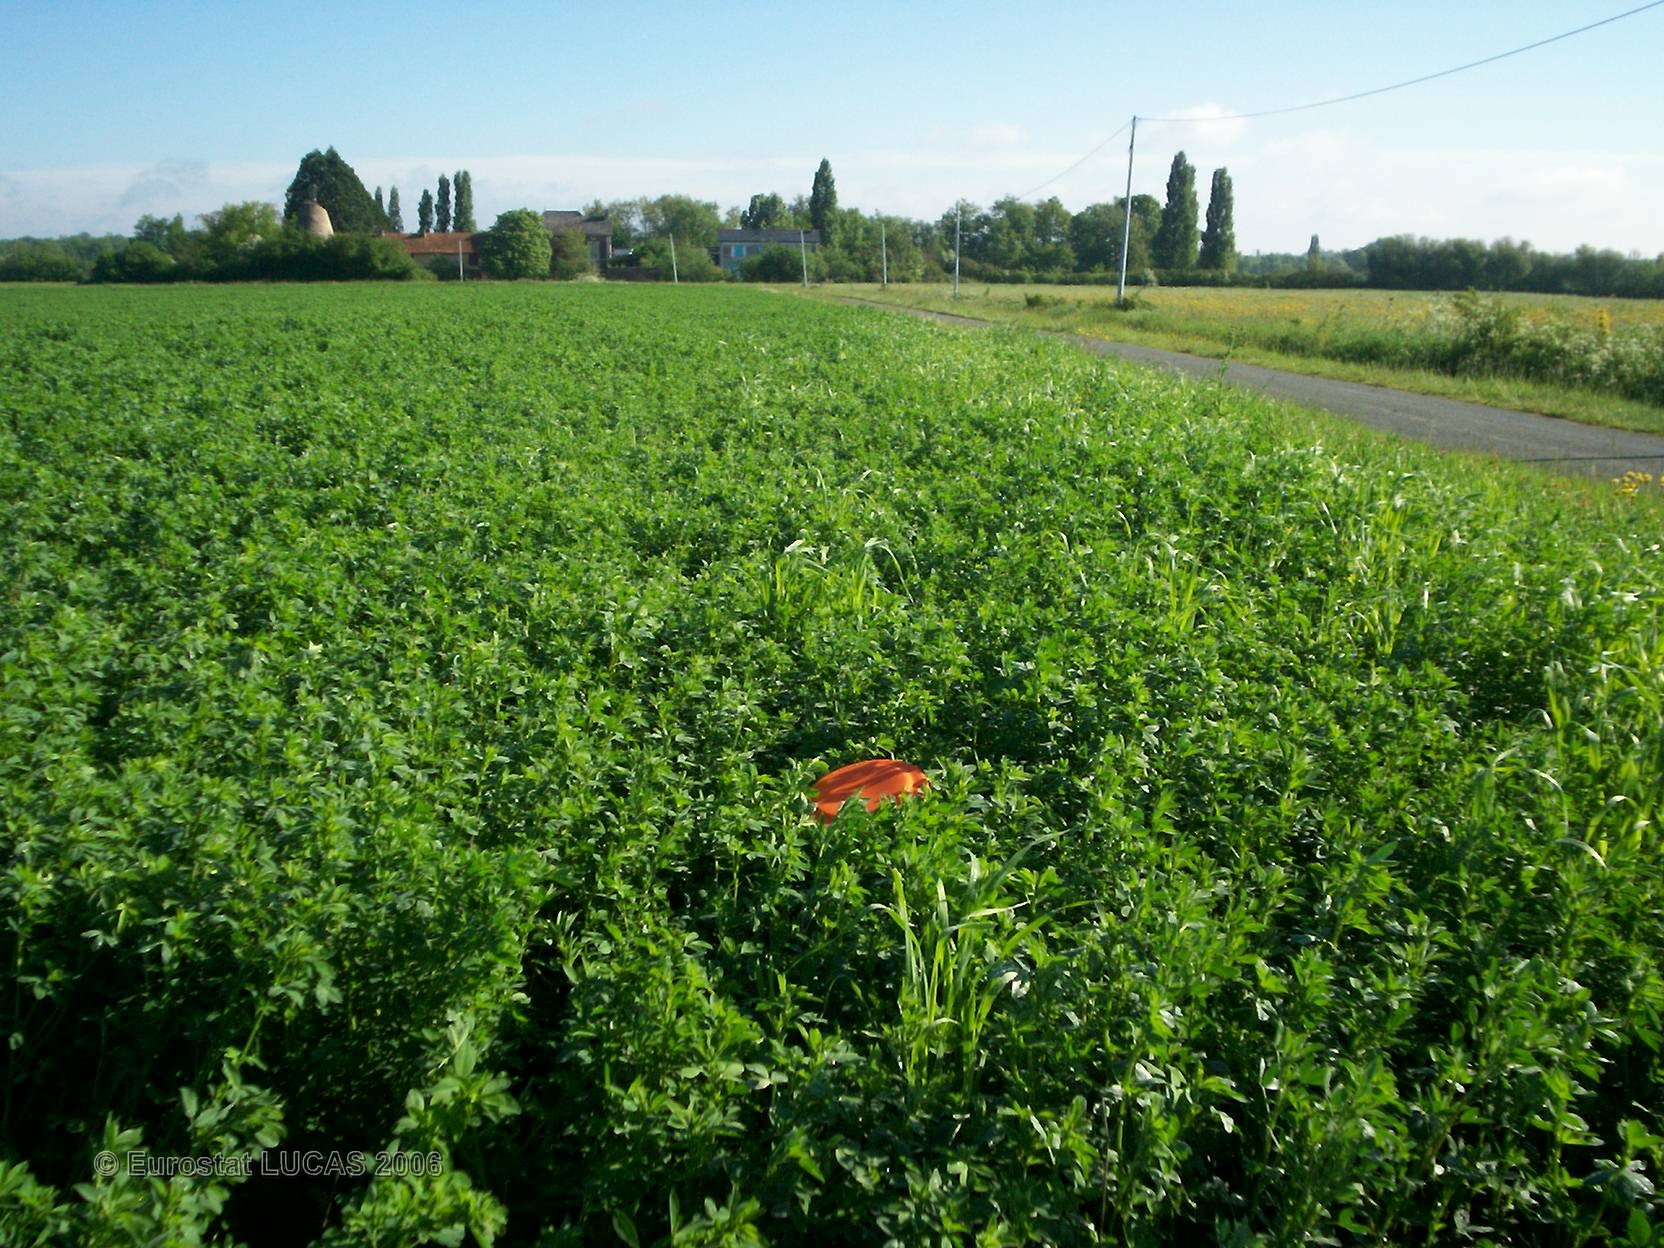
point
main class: Cropland
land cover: Lucerne
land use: Agriculture (excluding fallow land and kitchen gardens)
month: May
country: FR
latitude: 47.2074
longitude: -0.3657
